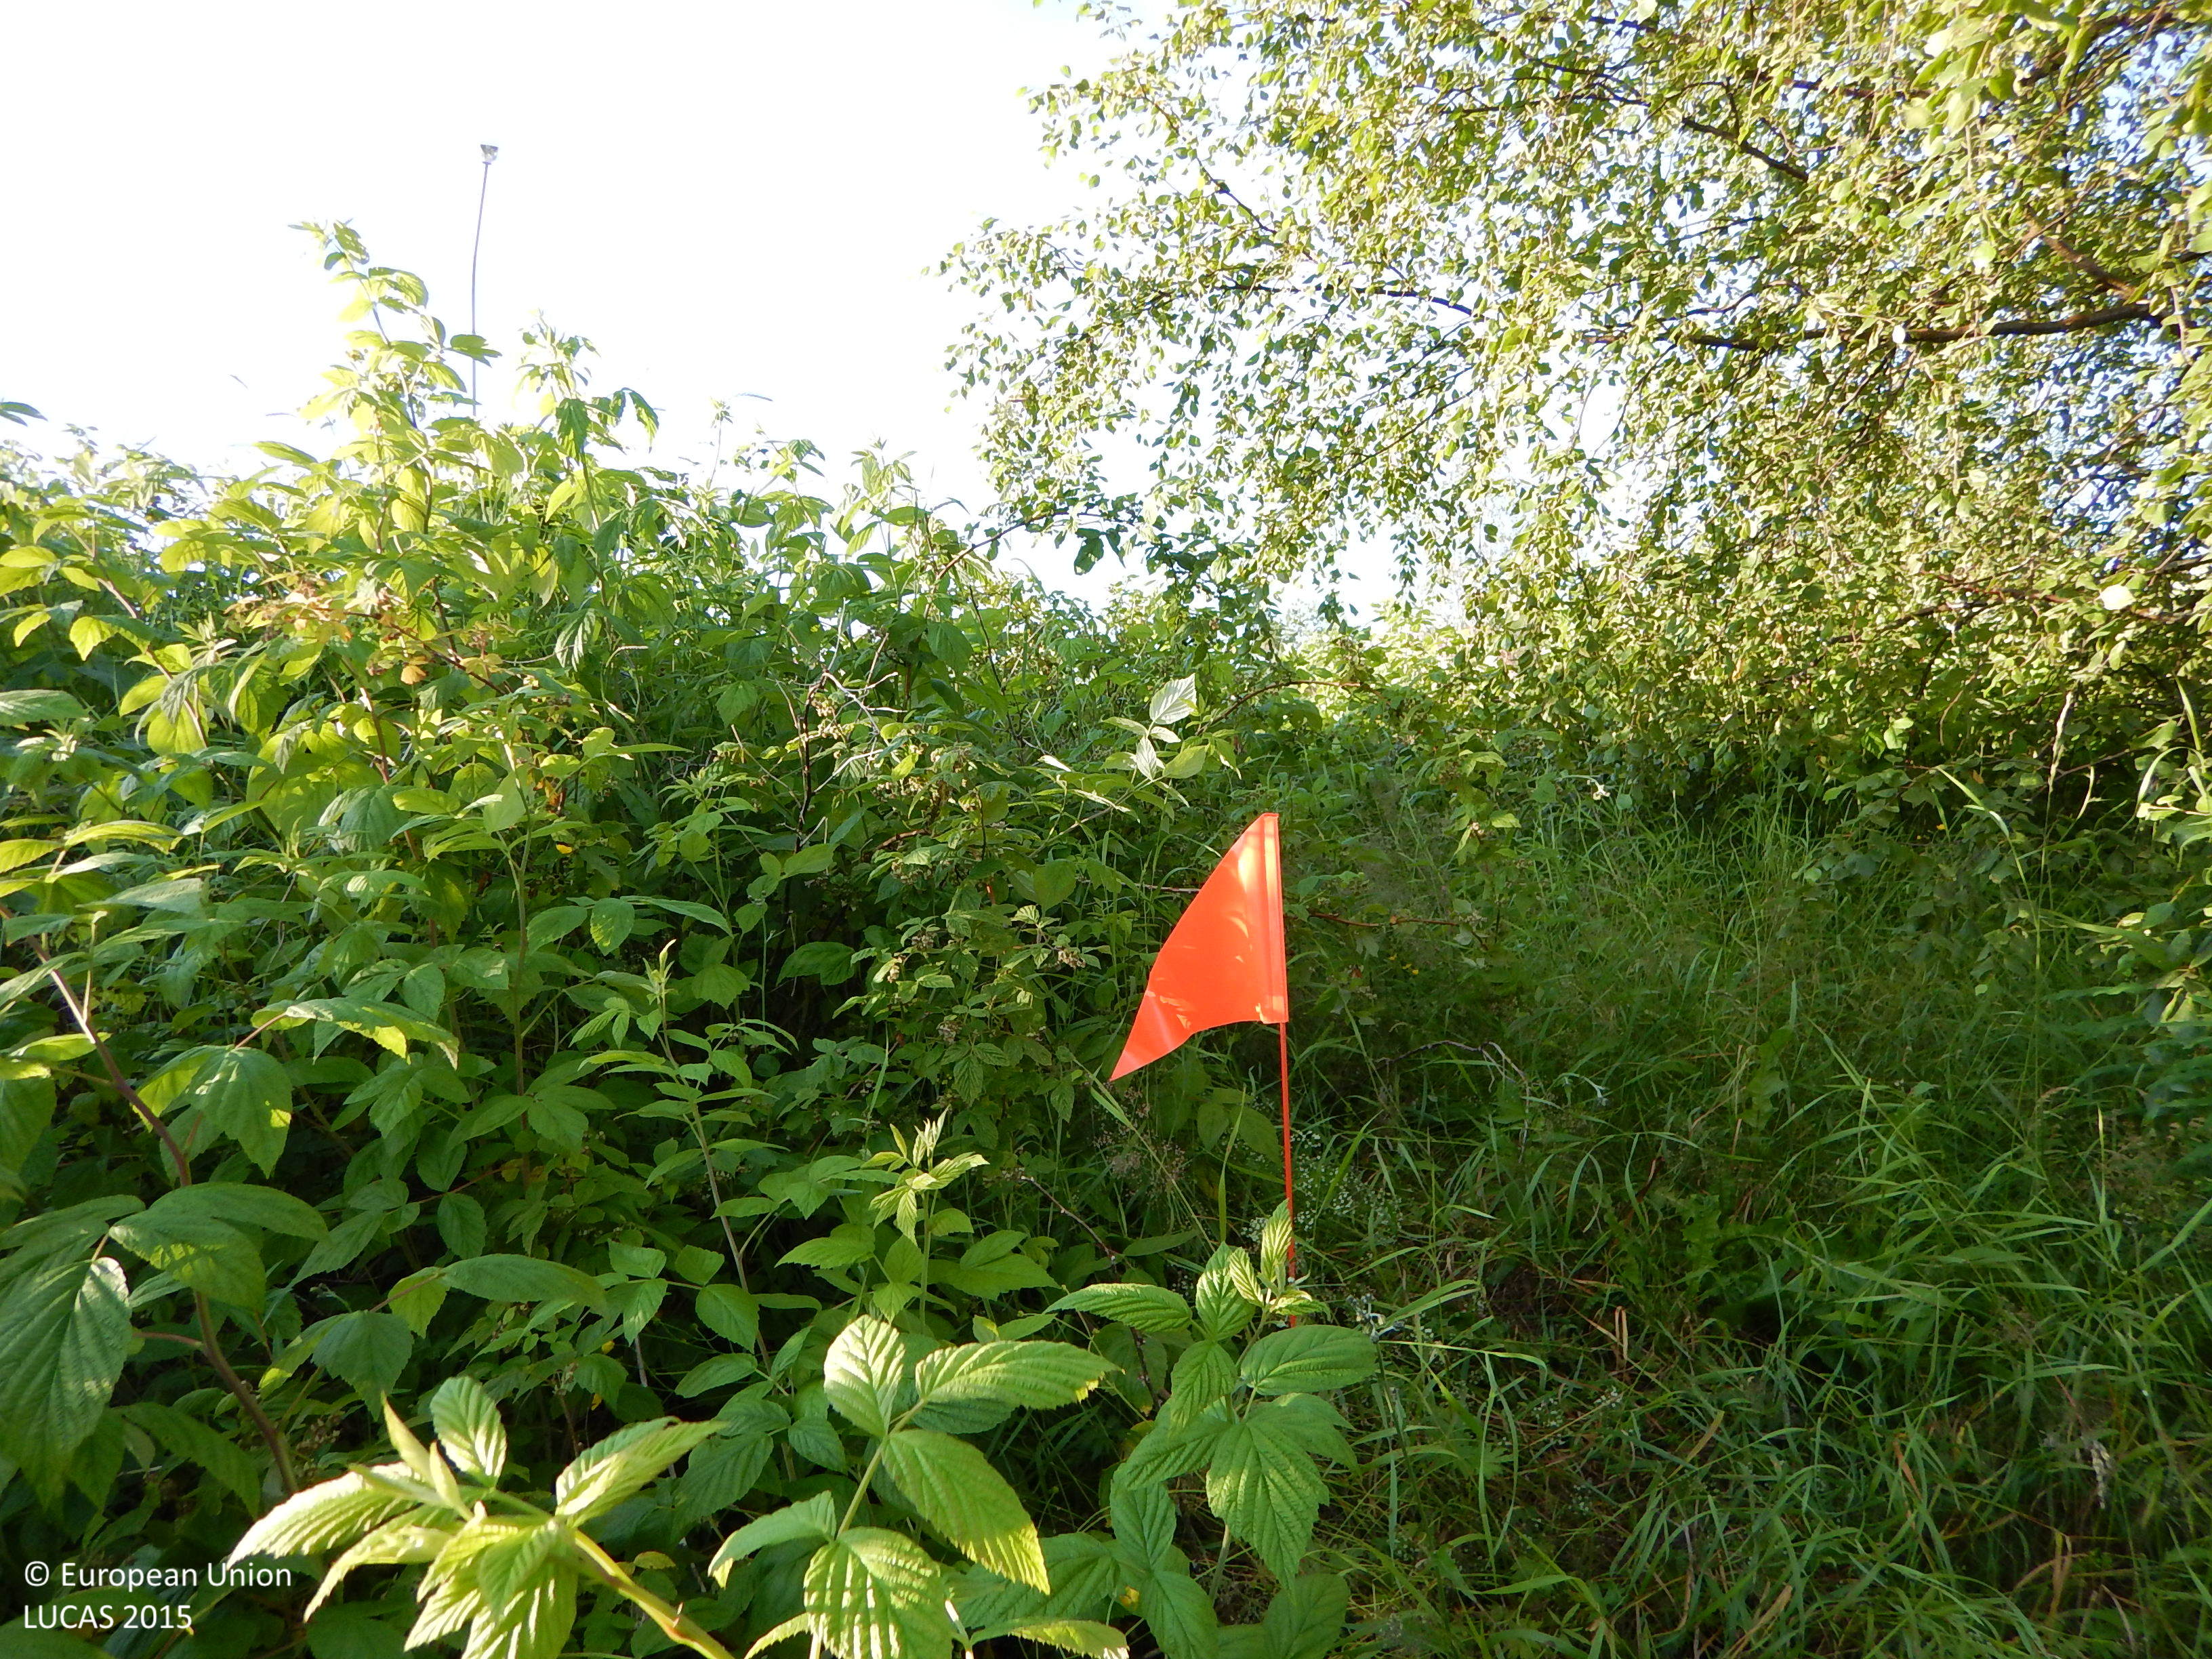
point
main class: Woodland
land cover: Broadleaved woodland
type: boreal forest
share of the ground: 50 - 75 %
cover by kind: broadleaved forest trees 50 %, shrubs 20 %, herbaceous plants 20 %, coniferous forest trees 10 %
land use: Semi-natural and natural areas not in use
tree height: > 5 m
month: July
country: SE
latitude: 64.7659
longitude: 20.9729
